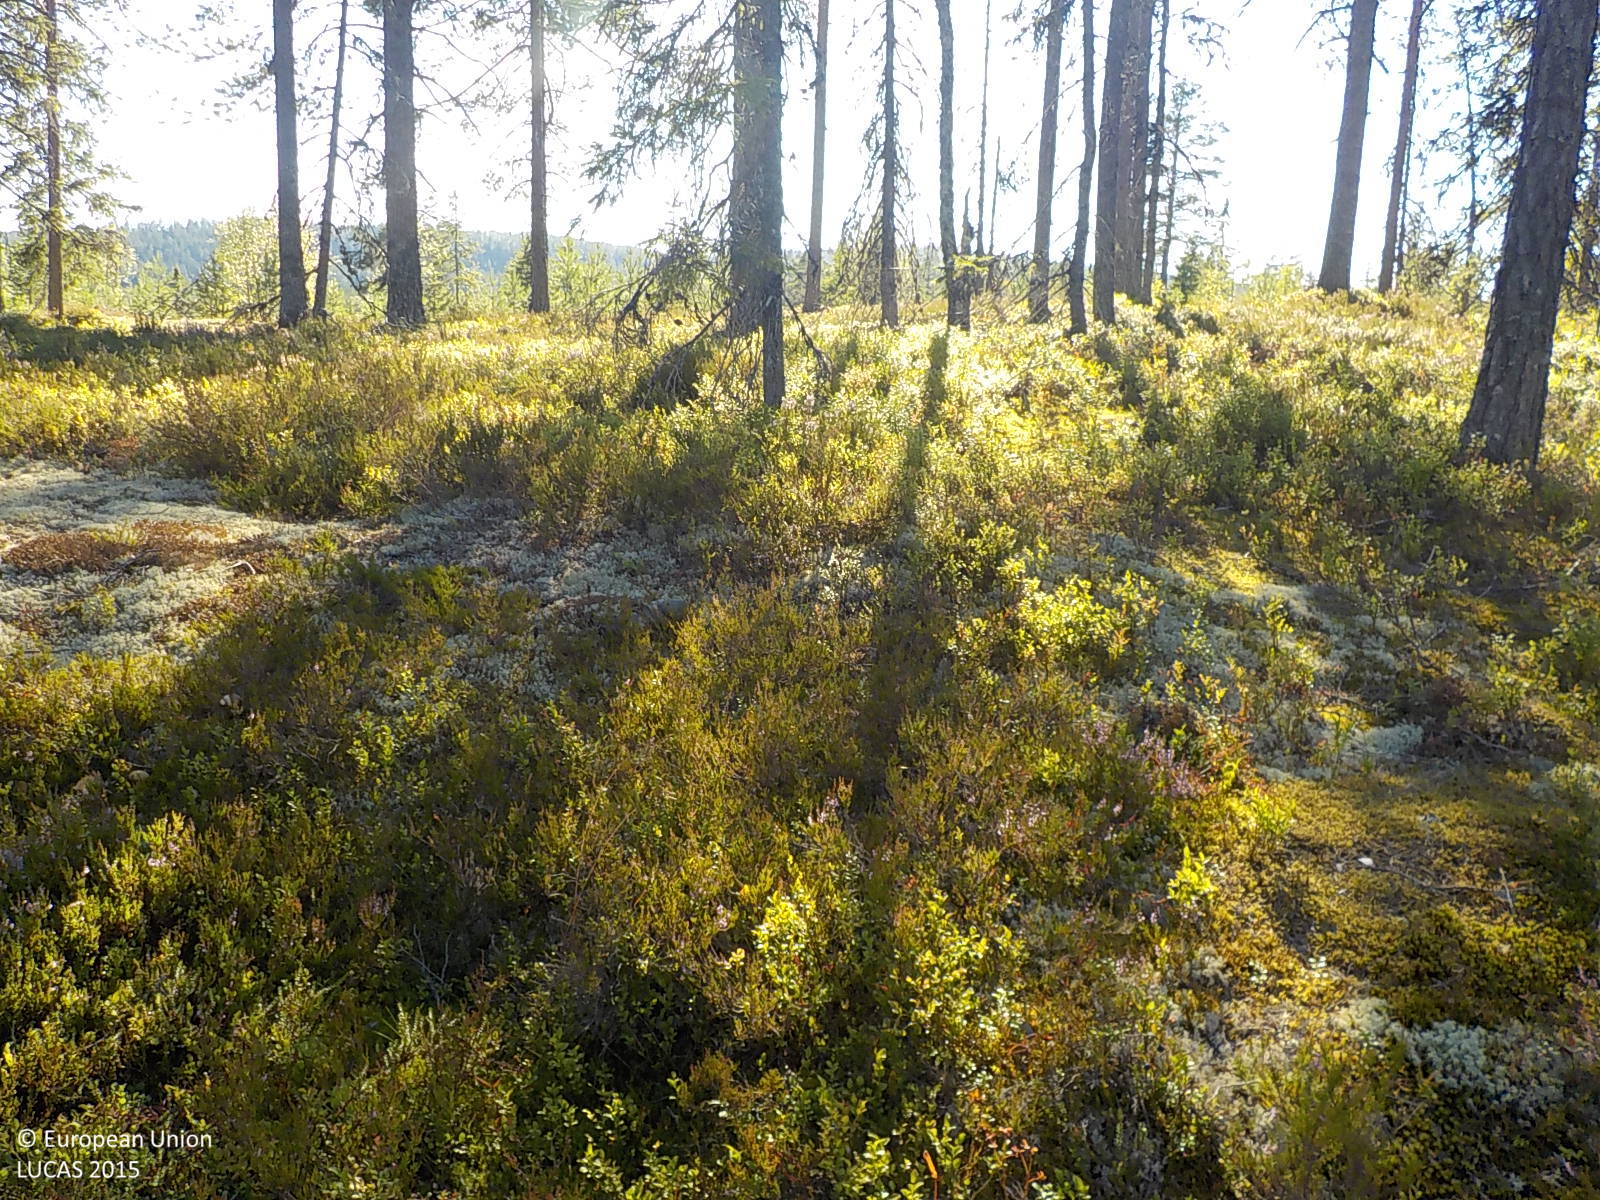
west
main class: Woodland
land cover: Pine dominated coniferous woodland
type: boreal forest
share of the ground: 25 - 50 %
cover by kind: shrubs 55 %, coniferous forest trees 40 %, broadleaved forest trees 5 %
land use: Forestry
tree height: > 5 m
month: August
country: SE
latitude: 63.4011
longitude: 18.6051
